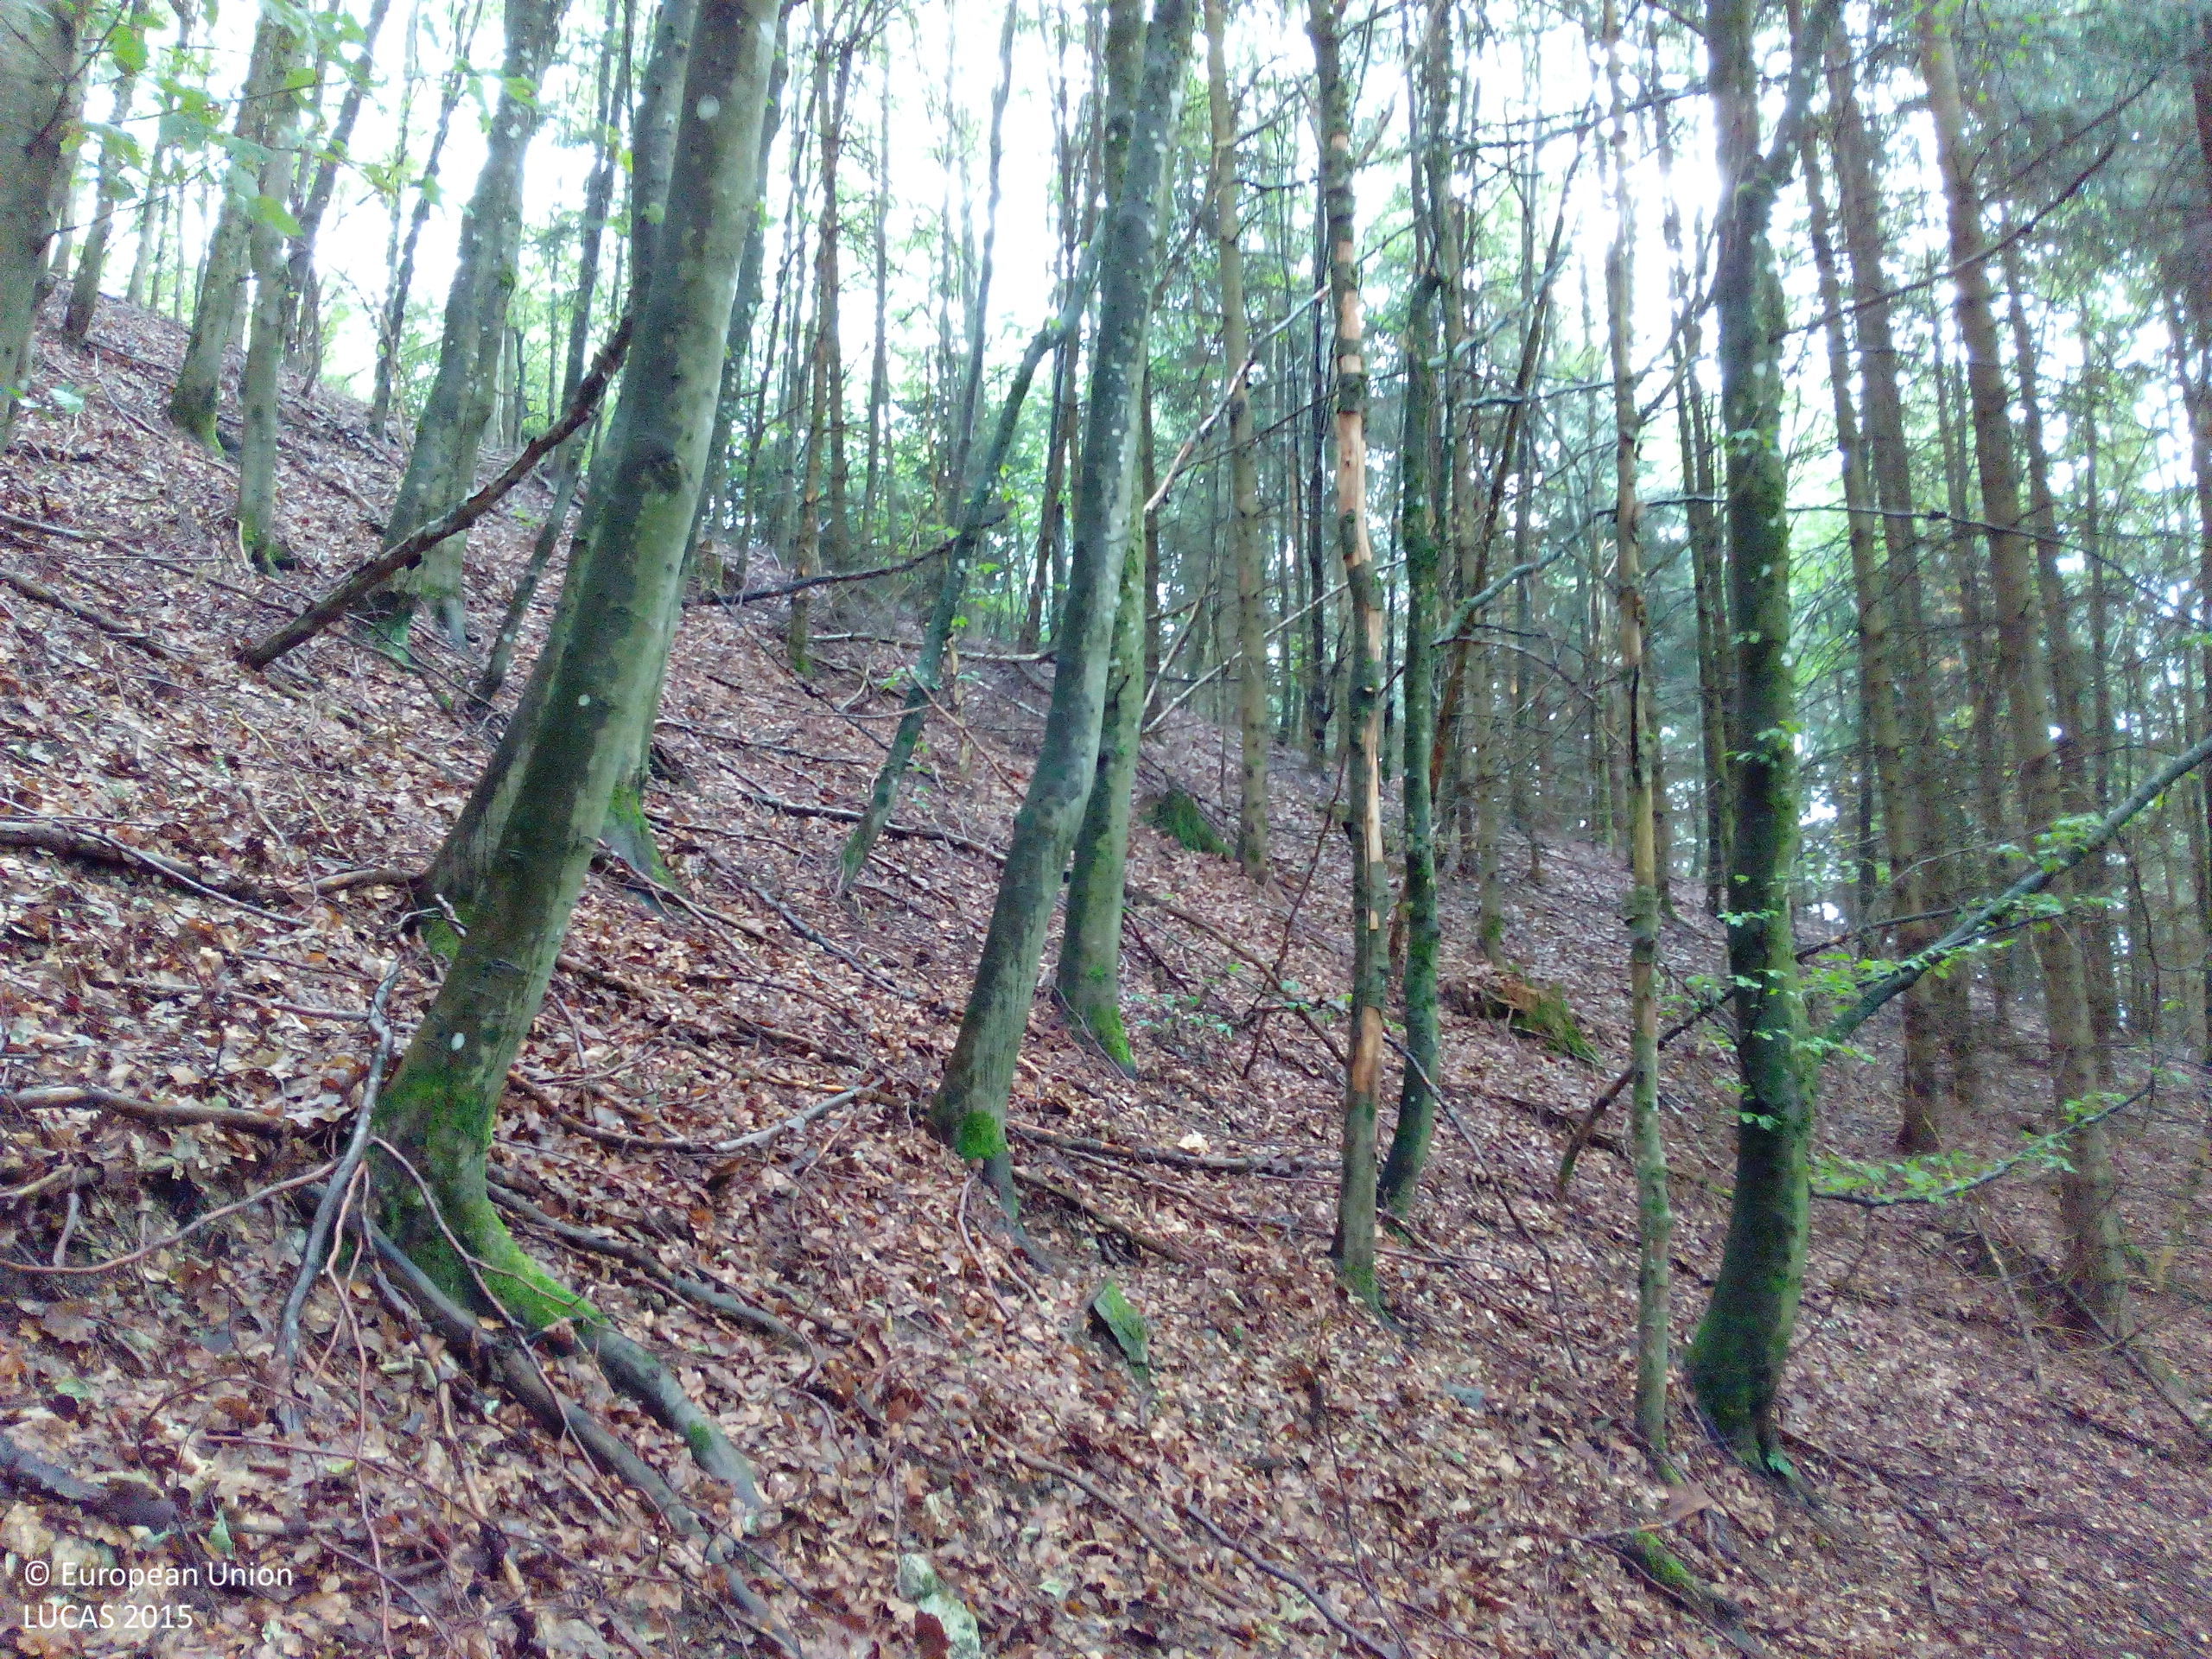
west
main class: Woodland
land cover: Broadleaved woodland
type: beech forest
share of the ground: > 75 %
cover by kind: broadleaved forest trees 90 %, unconsolidated bare surface 10 %
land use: Forestry
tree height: > 5 m
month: July
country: DE
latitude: 48.1713
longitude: 8.1050
